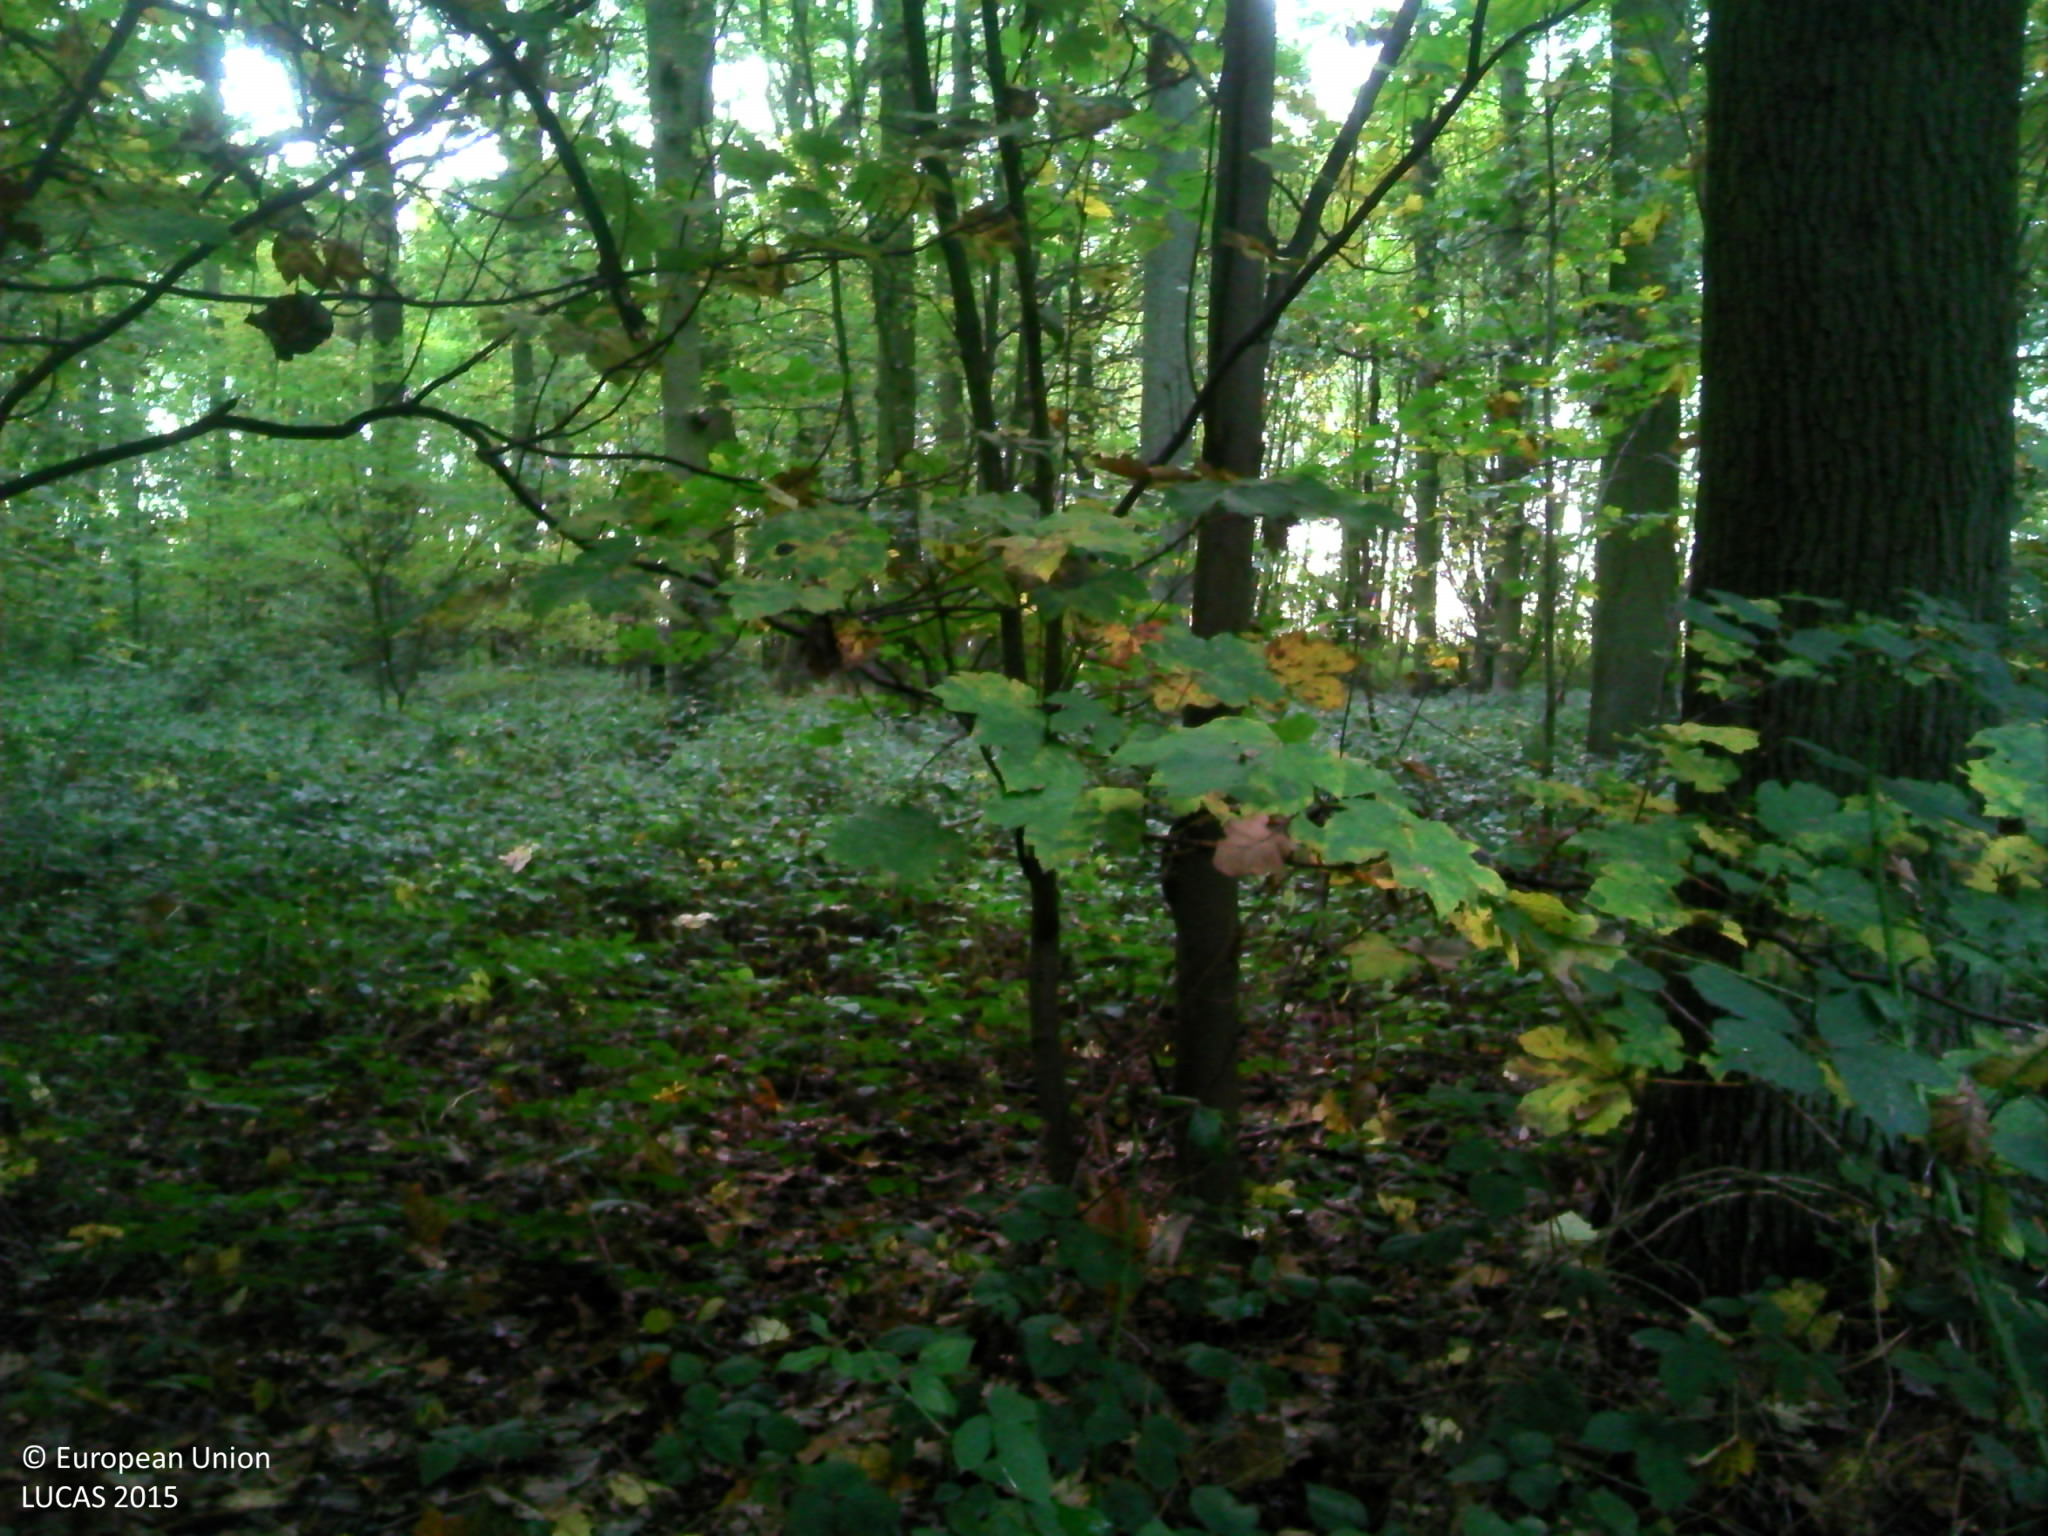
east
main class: Woodland
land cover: Broadleaved woodland
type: mesophytic deciduous forest
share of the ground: > 75 %
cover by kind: broadleaved forest trees 95 %, herbaceous plants 5 %
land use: Forestry
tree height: > 5 m
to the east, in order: Broadleaved woodland; Spontaneously vegetated surfaces; Fences; Grassland without tree/shrub cover; Fences; Grassland without tree/shrub cover; Tracks; Grass margins; Fences; Grassland without tree/shrub cover
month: October
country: BE
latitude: 50.9355
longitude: 4.5173
